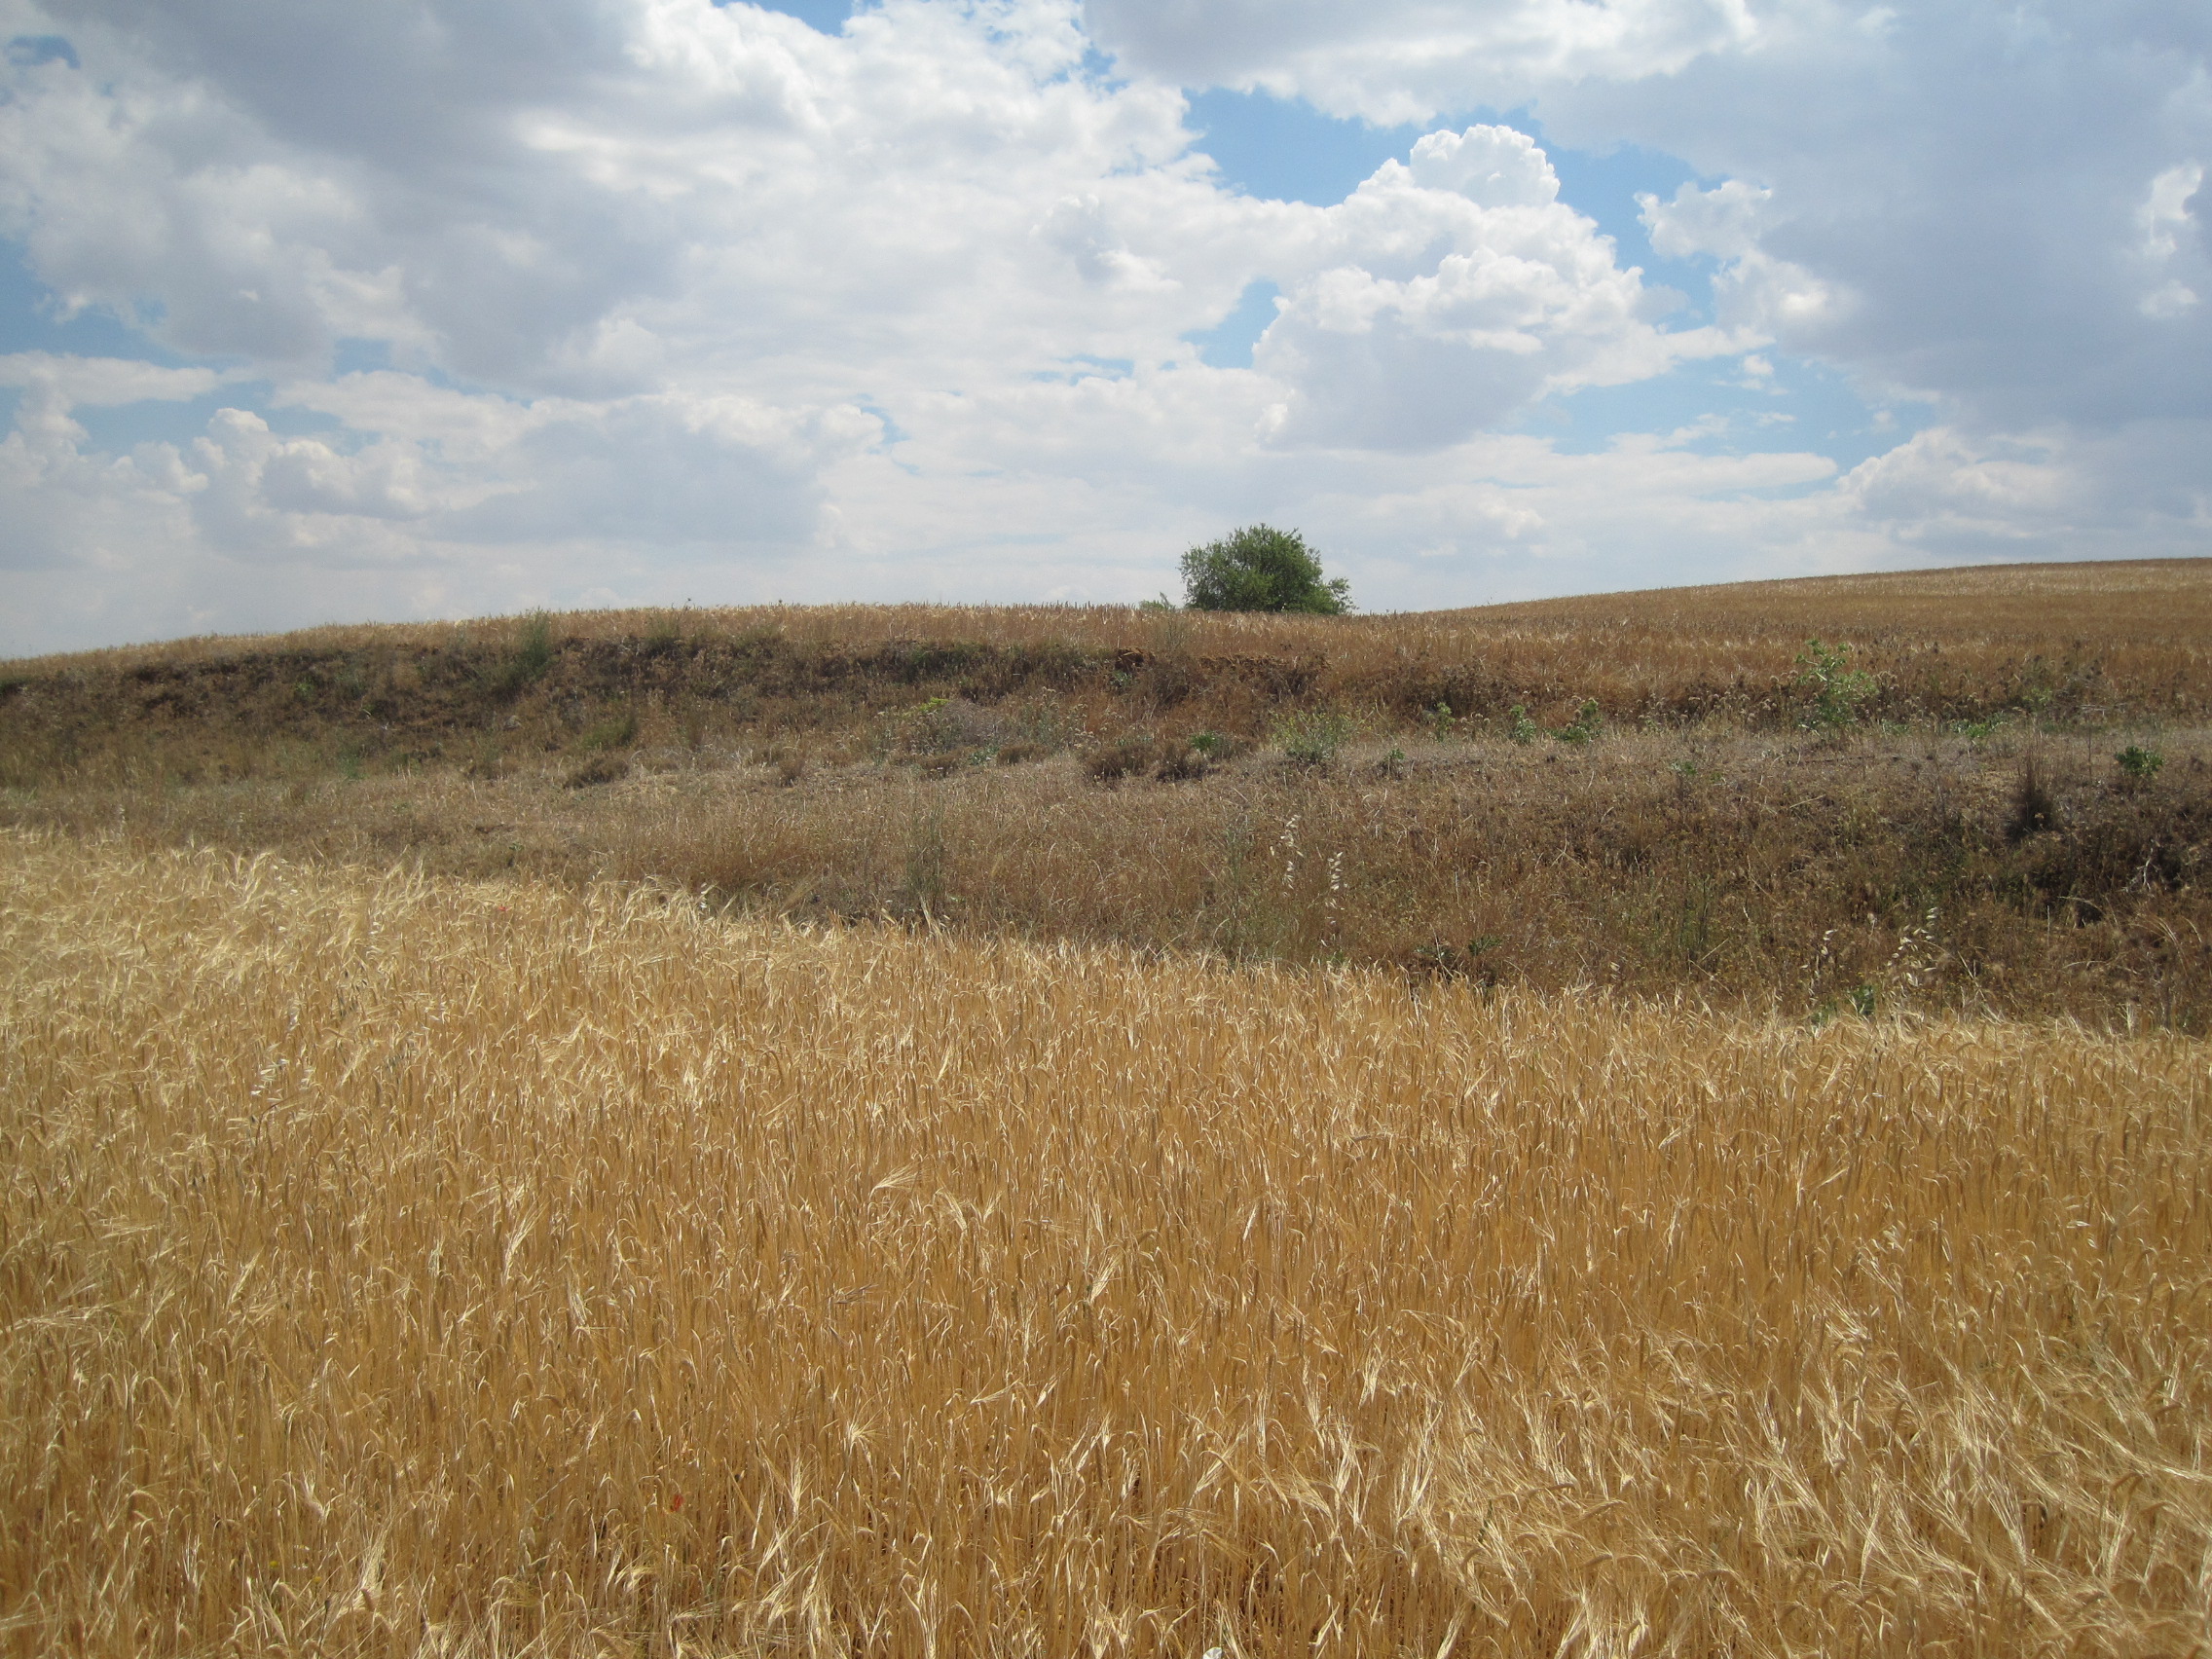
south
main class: Cropland
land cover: Barley
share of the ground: > 75 %
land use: Agriculture (excluding fallow land and kitchen gardens)
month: June
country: ES
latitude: 41.3601
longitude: -5.2684
